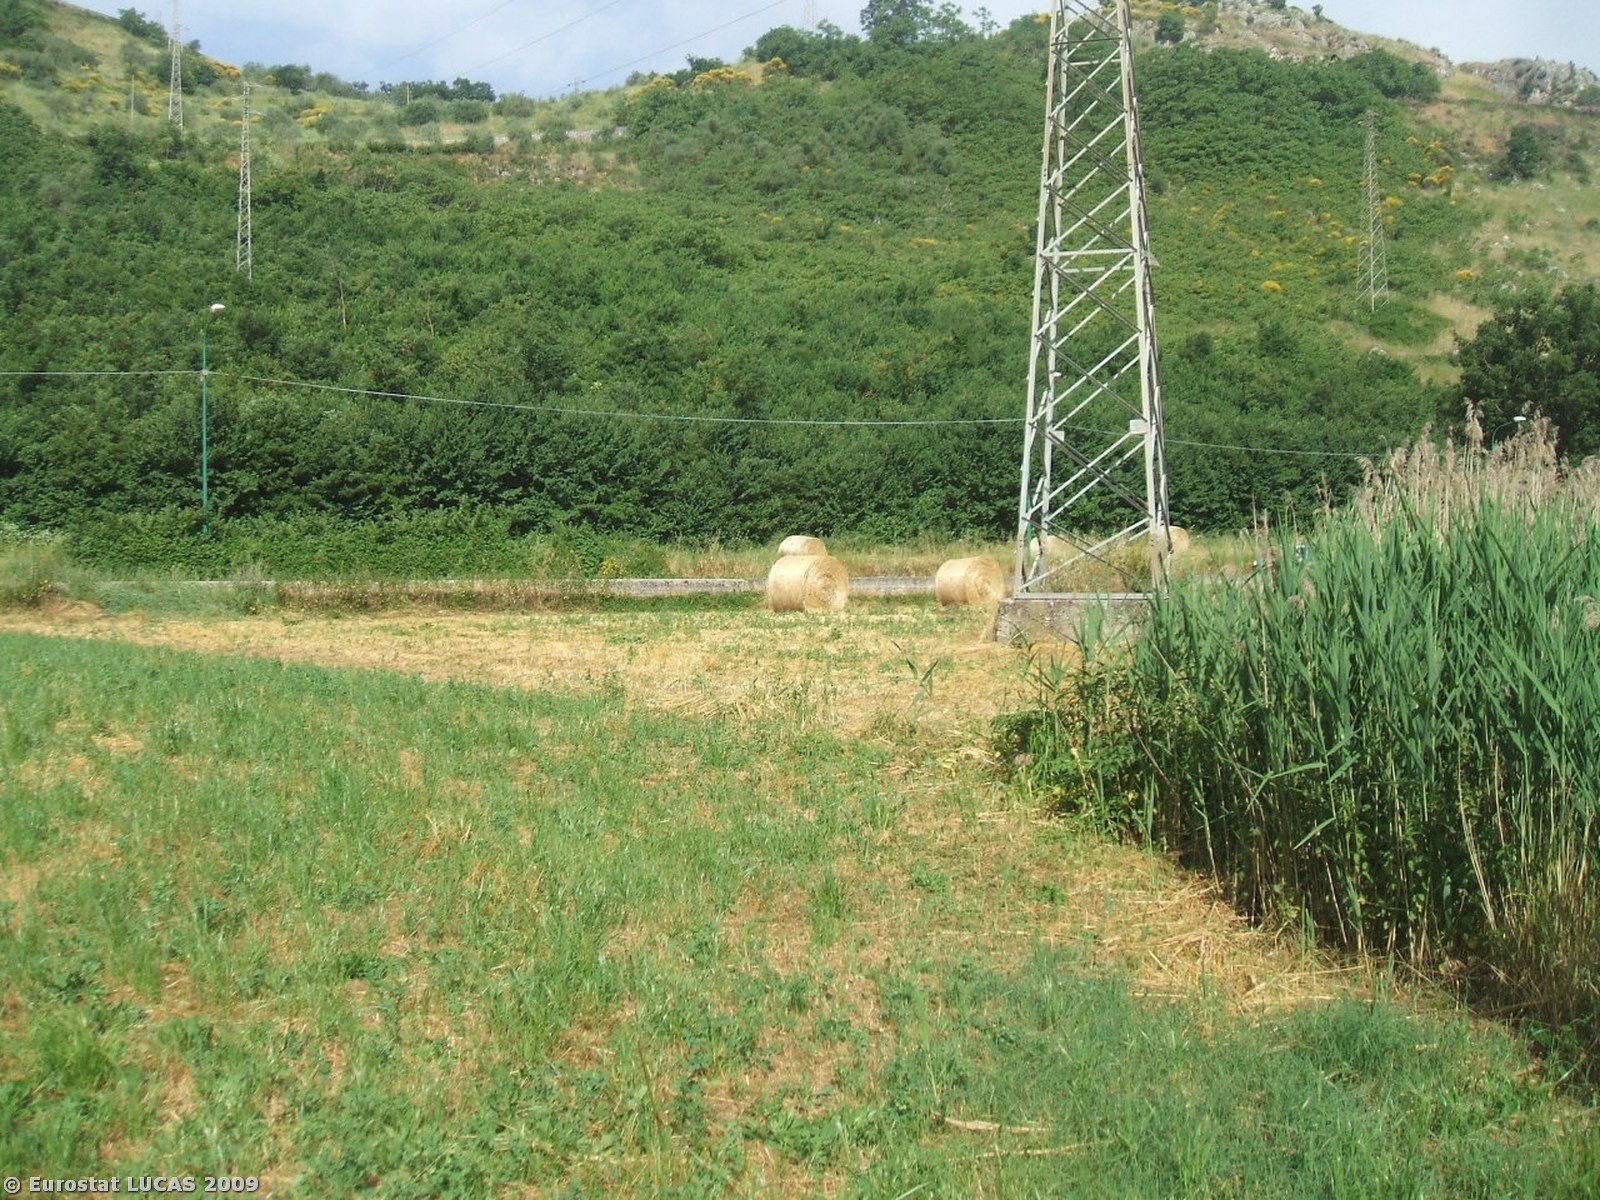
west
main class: Cropland
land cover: Other fresh vegetables
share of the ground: > 75 %
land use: Agriculture (excluding fallow land and kitchen gardens)
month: May
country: IT
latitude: 40.3823
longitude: 15.5484
